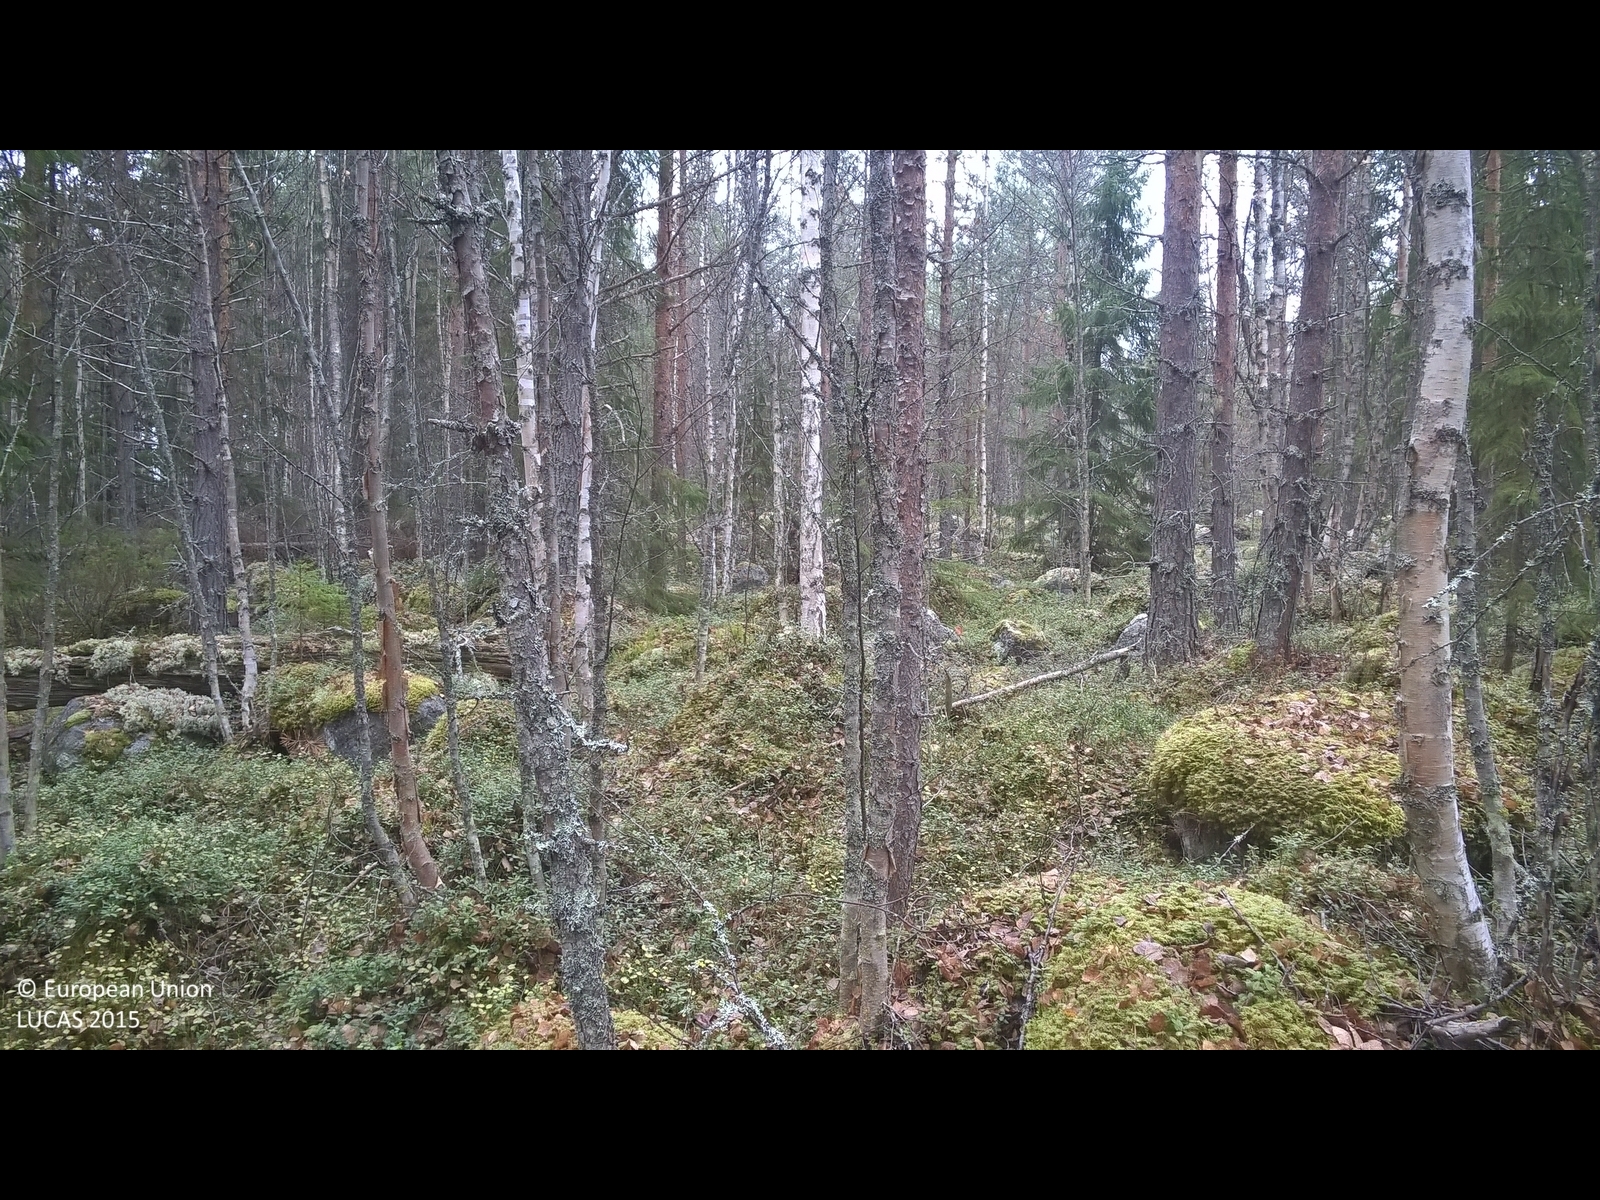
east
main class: Woodland
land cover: Other mixed woodland
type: boreal forest
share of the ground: > 75 %
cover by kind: coniferous forest trees 45 %, broadleaved forest trees 35 %, lichens and mosses 20 %
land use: Forestry
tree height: > 5 m
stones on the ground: 10 - 25 %
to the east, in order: Other mixed woodland; Inland fresh water bodies; Pine dominated coniferous woodland
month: October
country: SE
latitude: 62.9037
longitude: 15.1541
